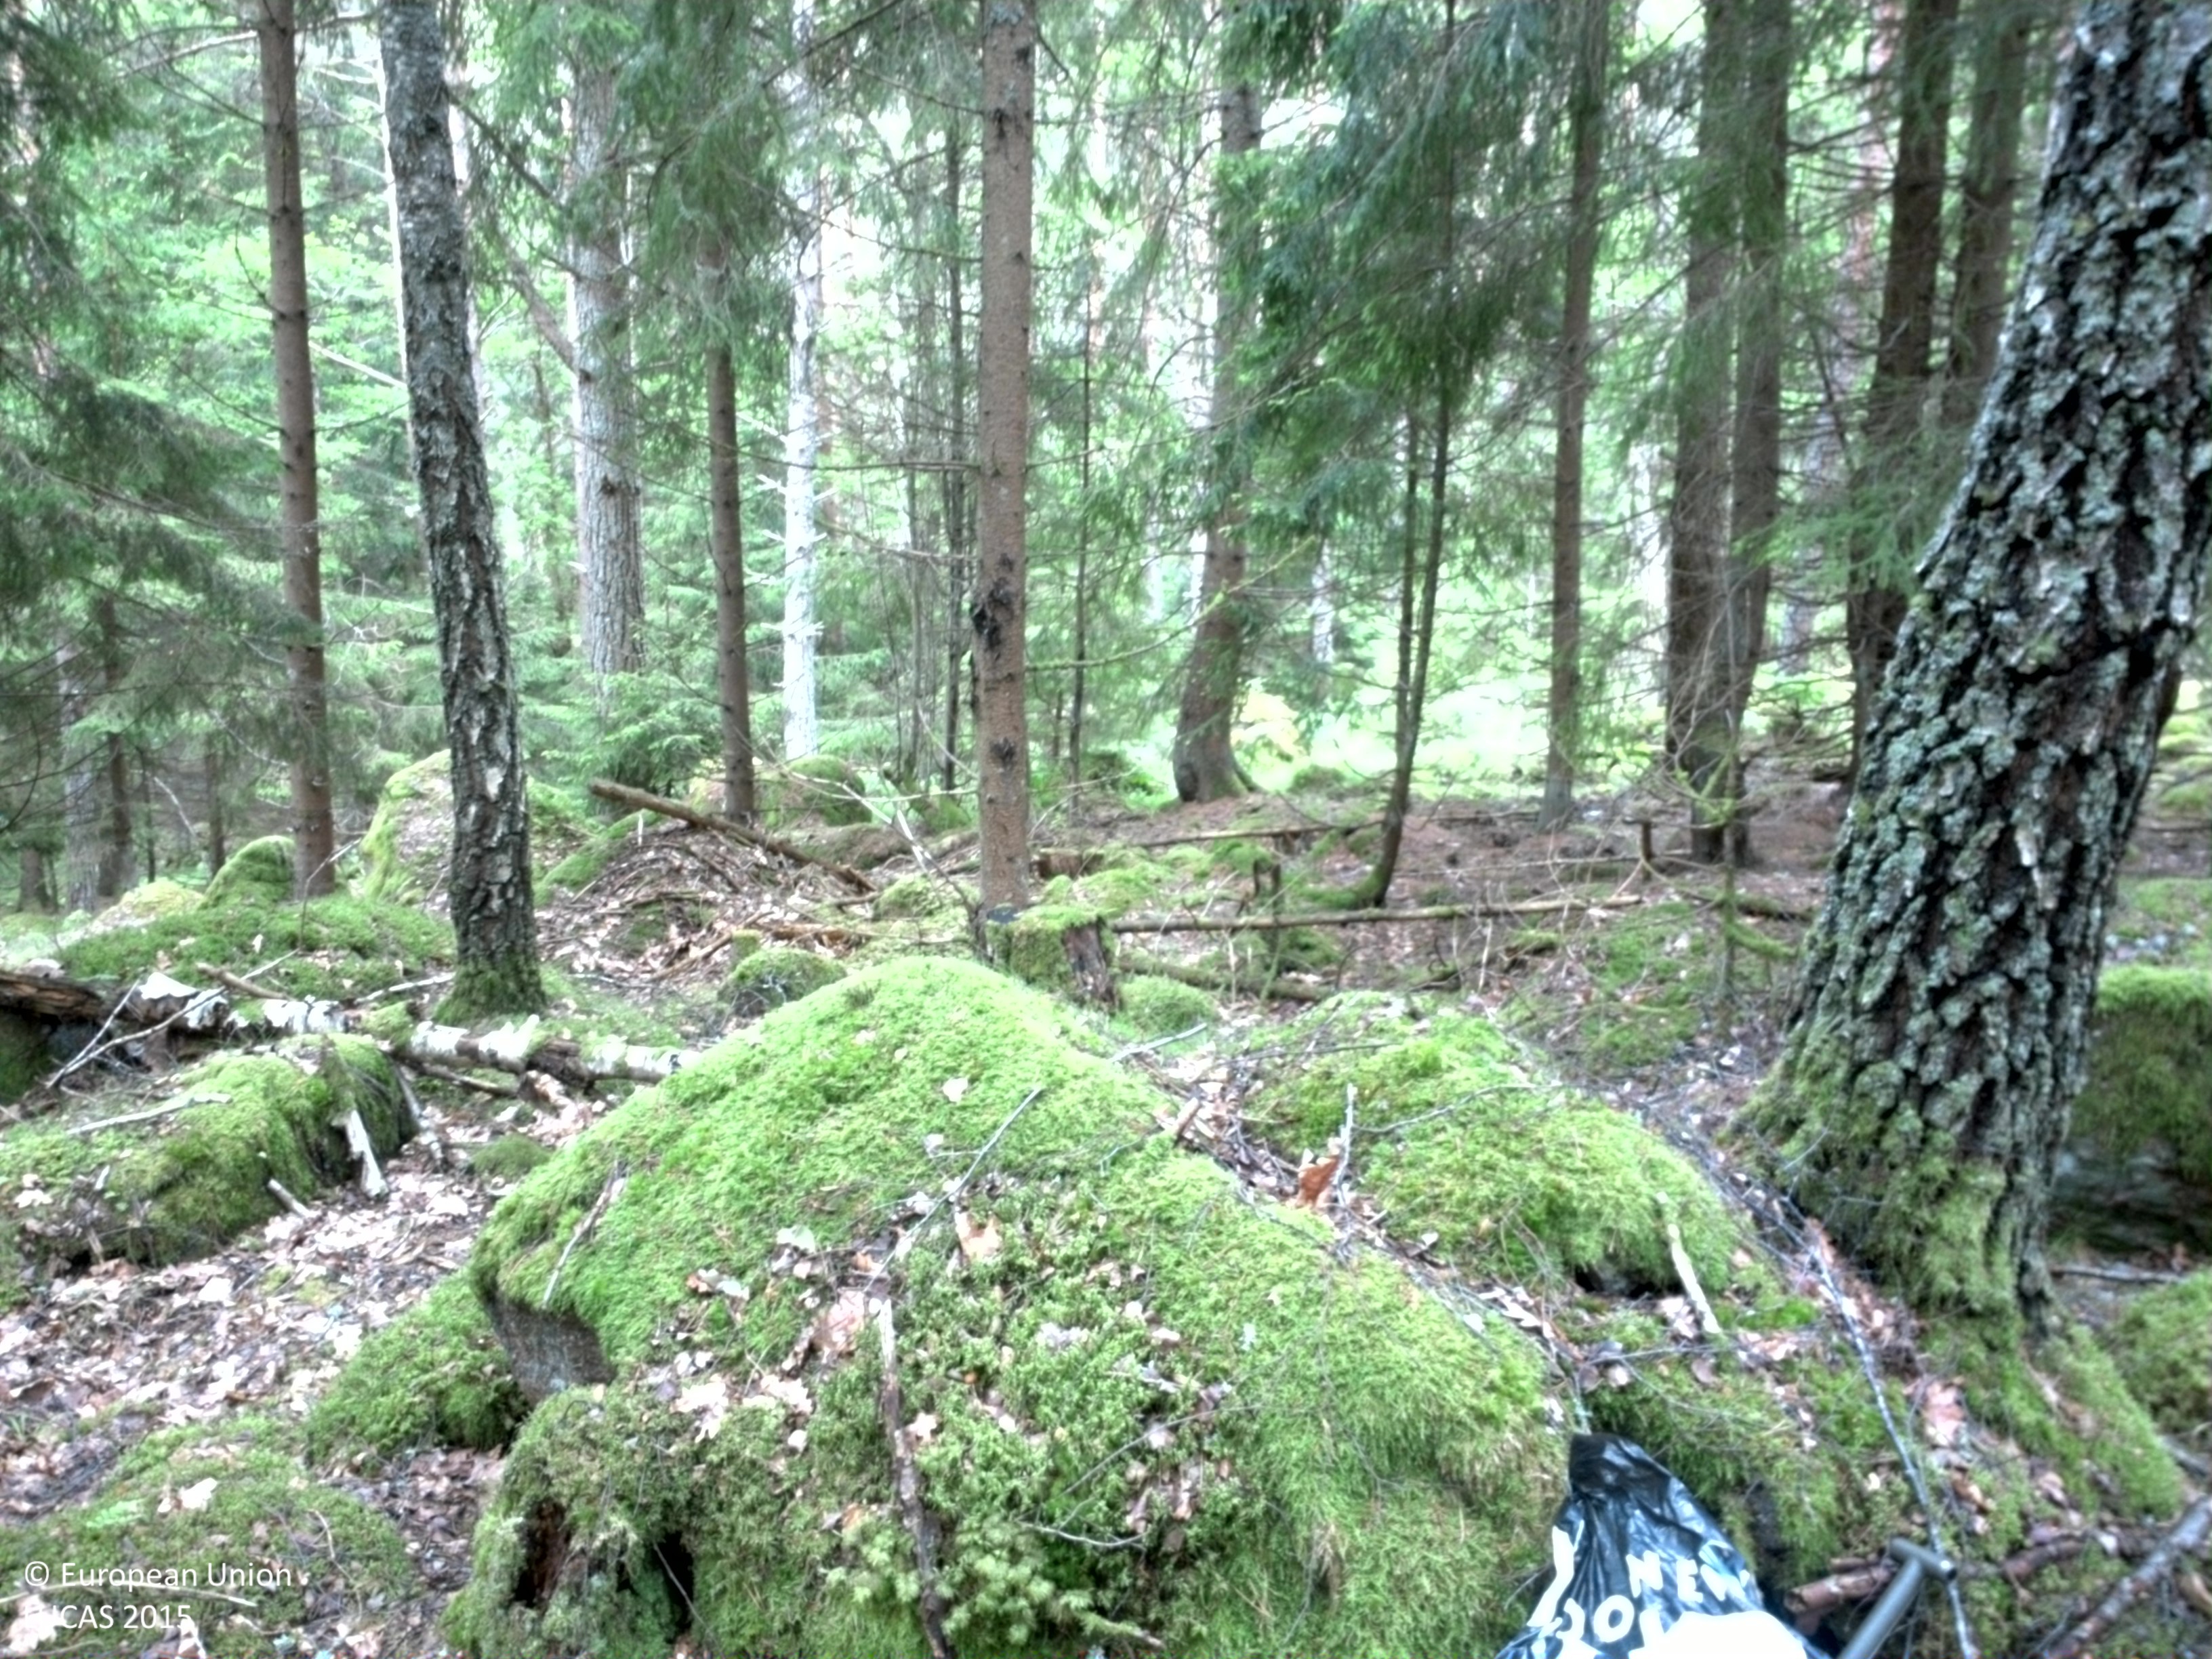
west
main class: Woodland
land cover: Spruce dominated coniferous woodland
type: boreal forest
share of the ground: 50 - 75 %
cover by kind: coniferous forest trees 70 %, lichens and mosses 30 %
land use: Forestry
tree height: > 5 m
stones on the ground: 10 - 25 %
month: June
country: SE
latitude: 58.5367
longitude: 15.5767
